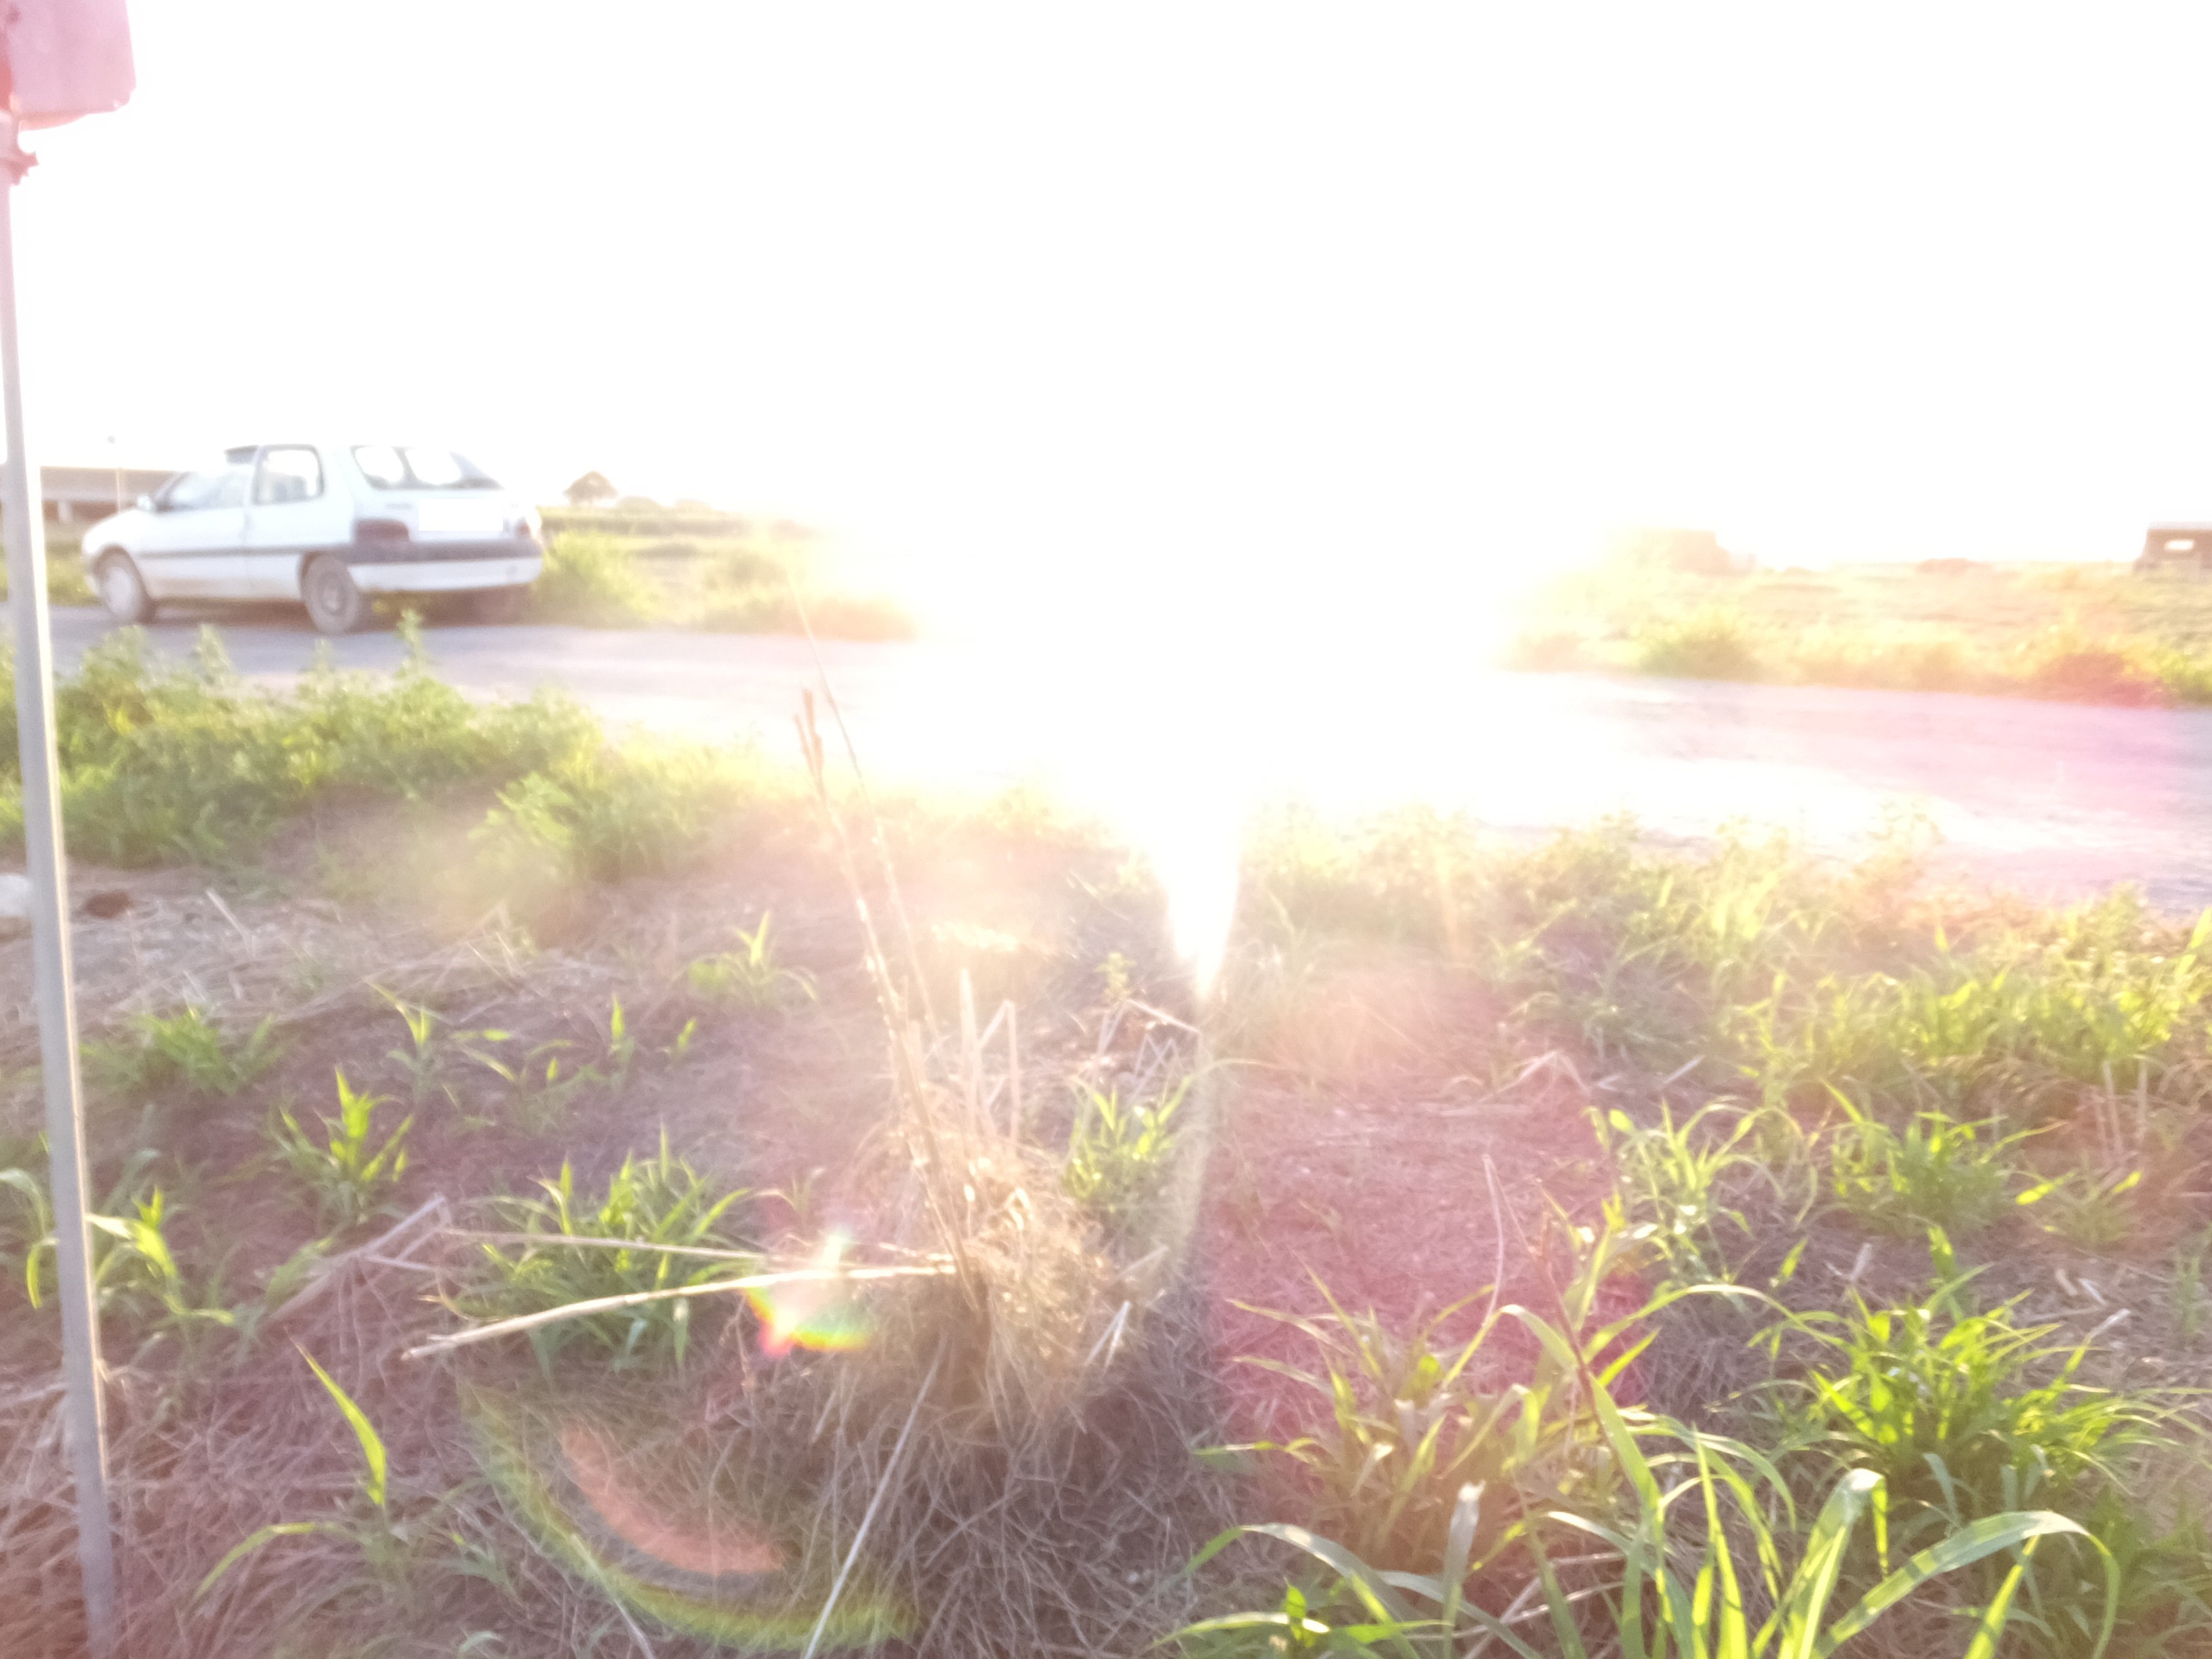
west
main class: Cropland
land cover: Maize
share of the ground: > 75 %
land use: Agriculture (excluding fallow land and kitchen gardens)
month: June
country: ES
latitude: 41.7809
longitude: 0.4203
